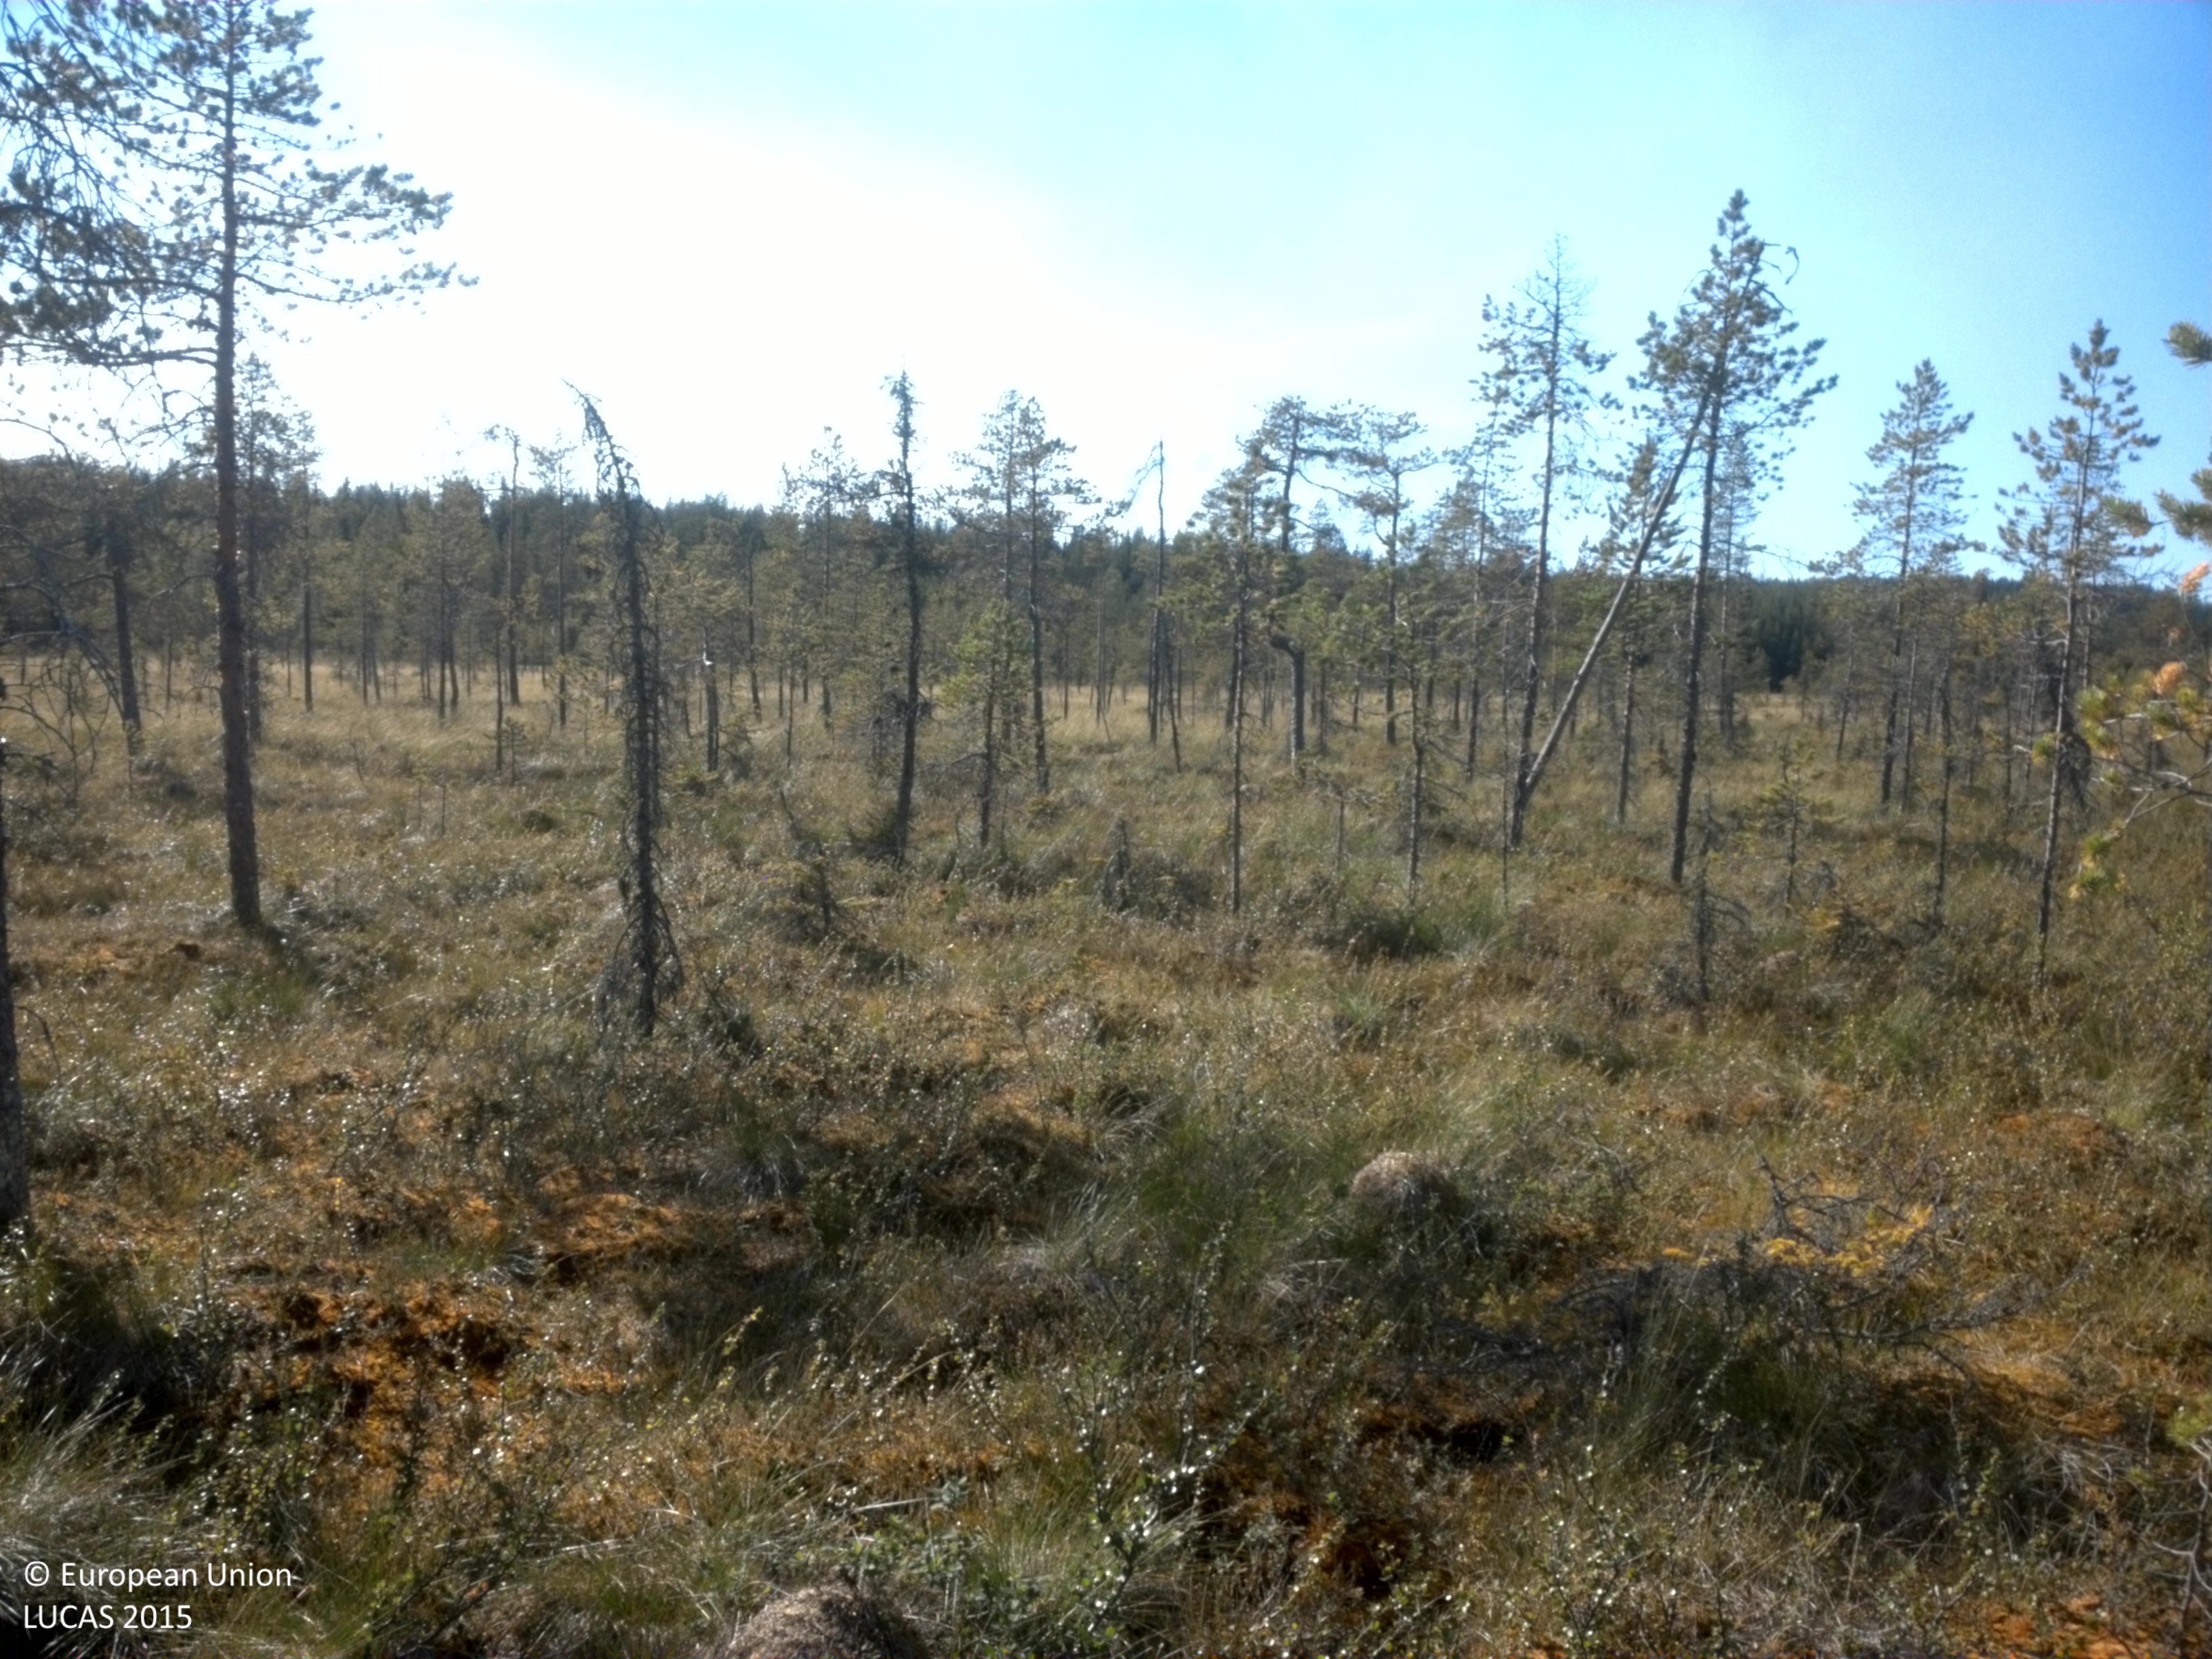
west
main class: Woodland
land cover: Pine dominated coniferous woodland
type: boreal forest
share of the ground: 25 - 50 %
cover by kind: coniferous forest trees 35 %, herbaceous plants 25 %, shrubs 20 %, lichens and mosses 20 %
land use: Semi-natural and natural areas not in use
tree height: > 5 m
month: August
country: SE
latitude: 64.5183
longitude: 18.4469
